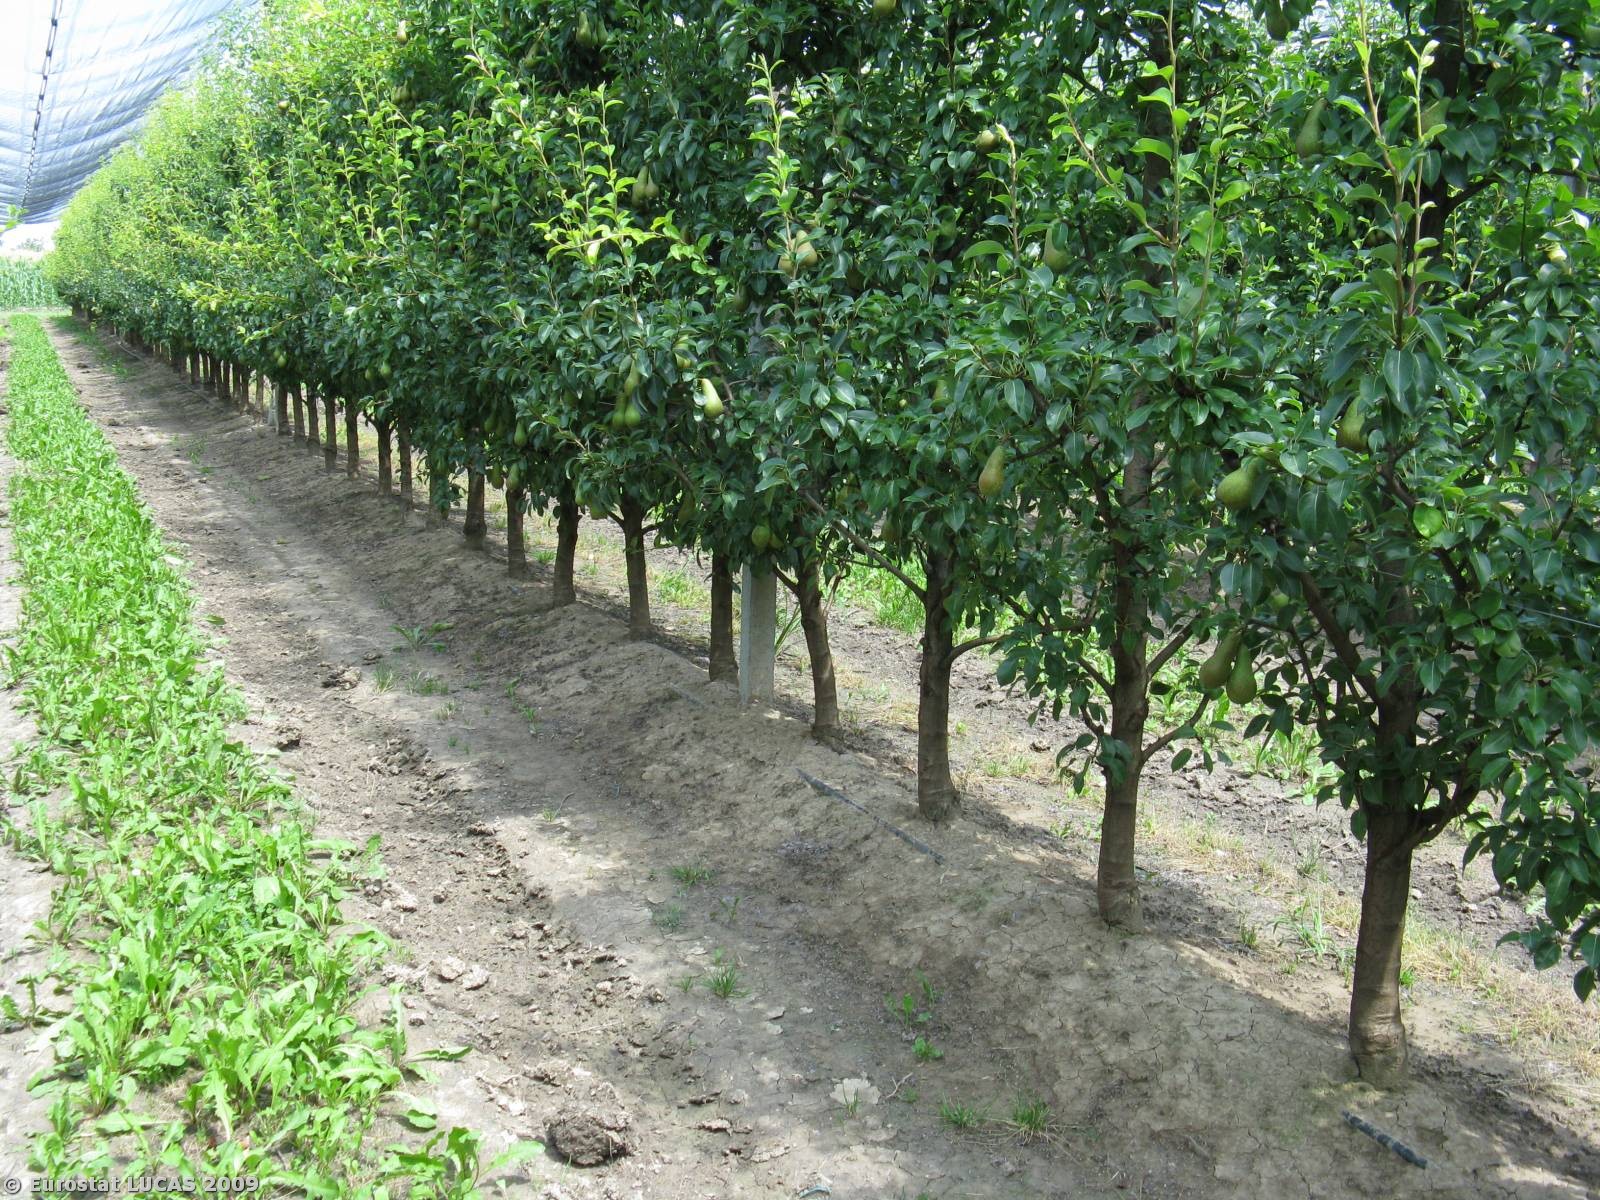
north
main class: Cropland
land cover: Pear fruit
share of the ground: 50 - 75 %
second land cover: Grassland with sparse tree/shrub cover
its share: 25 - 50 %
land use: Agriculture (excluding fallow land and kitchen gardens)
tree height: < 5 m
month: June
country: IT
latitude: 44.7523
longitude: 11.6514
